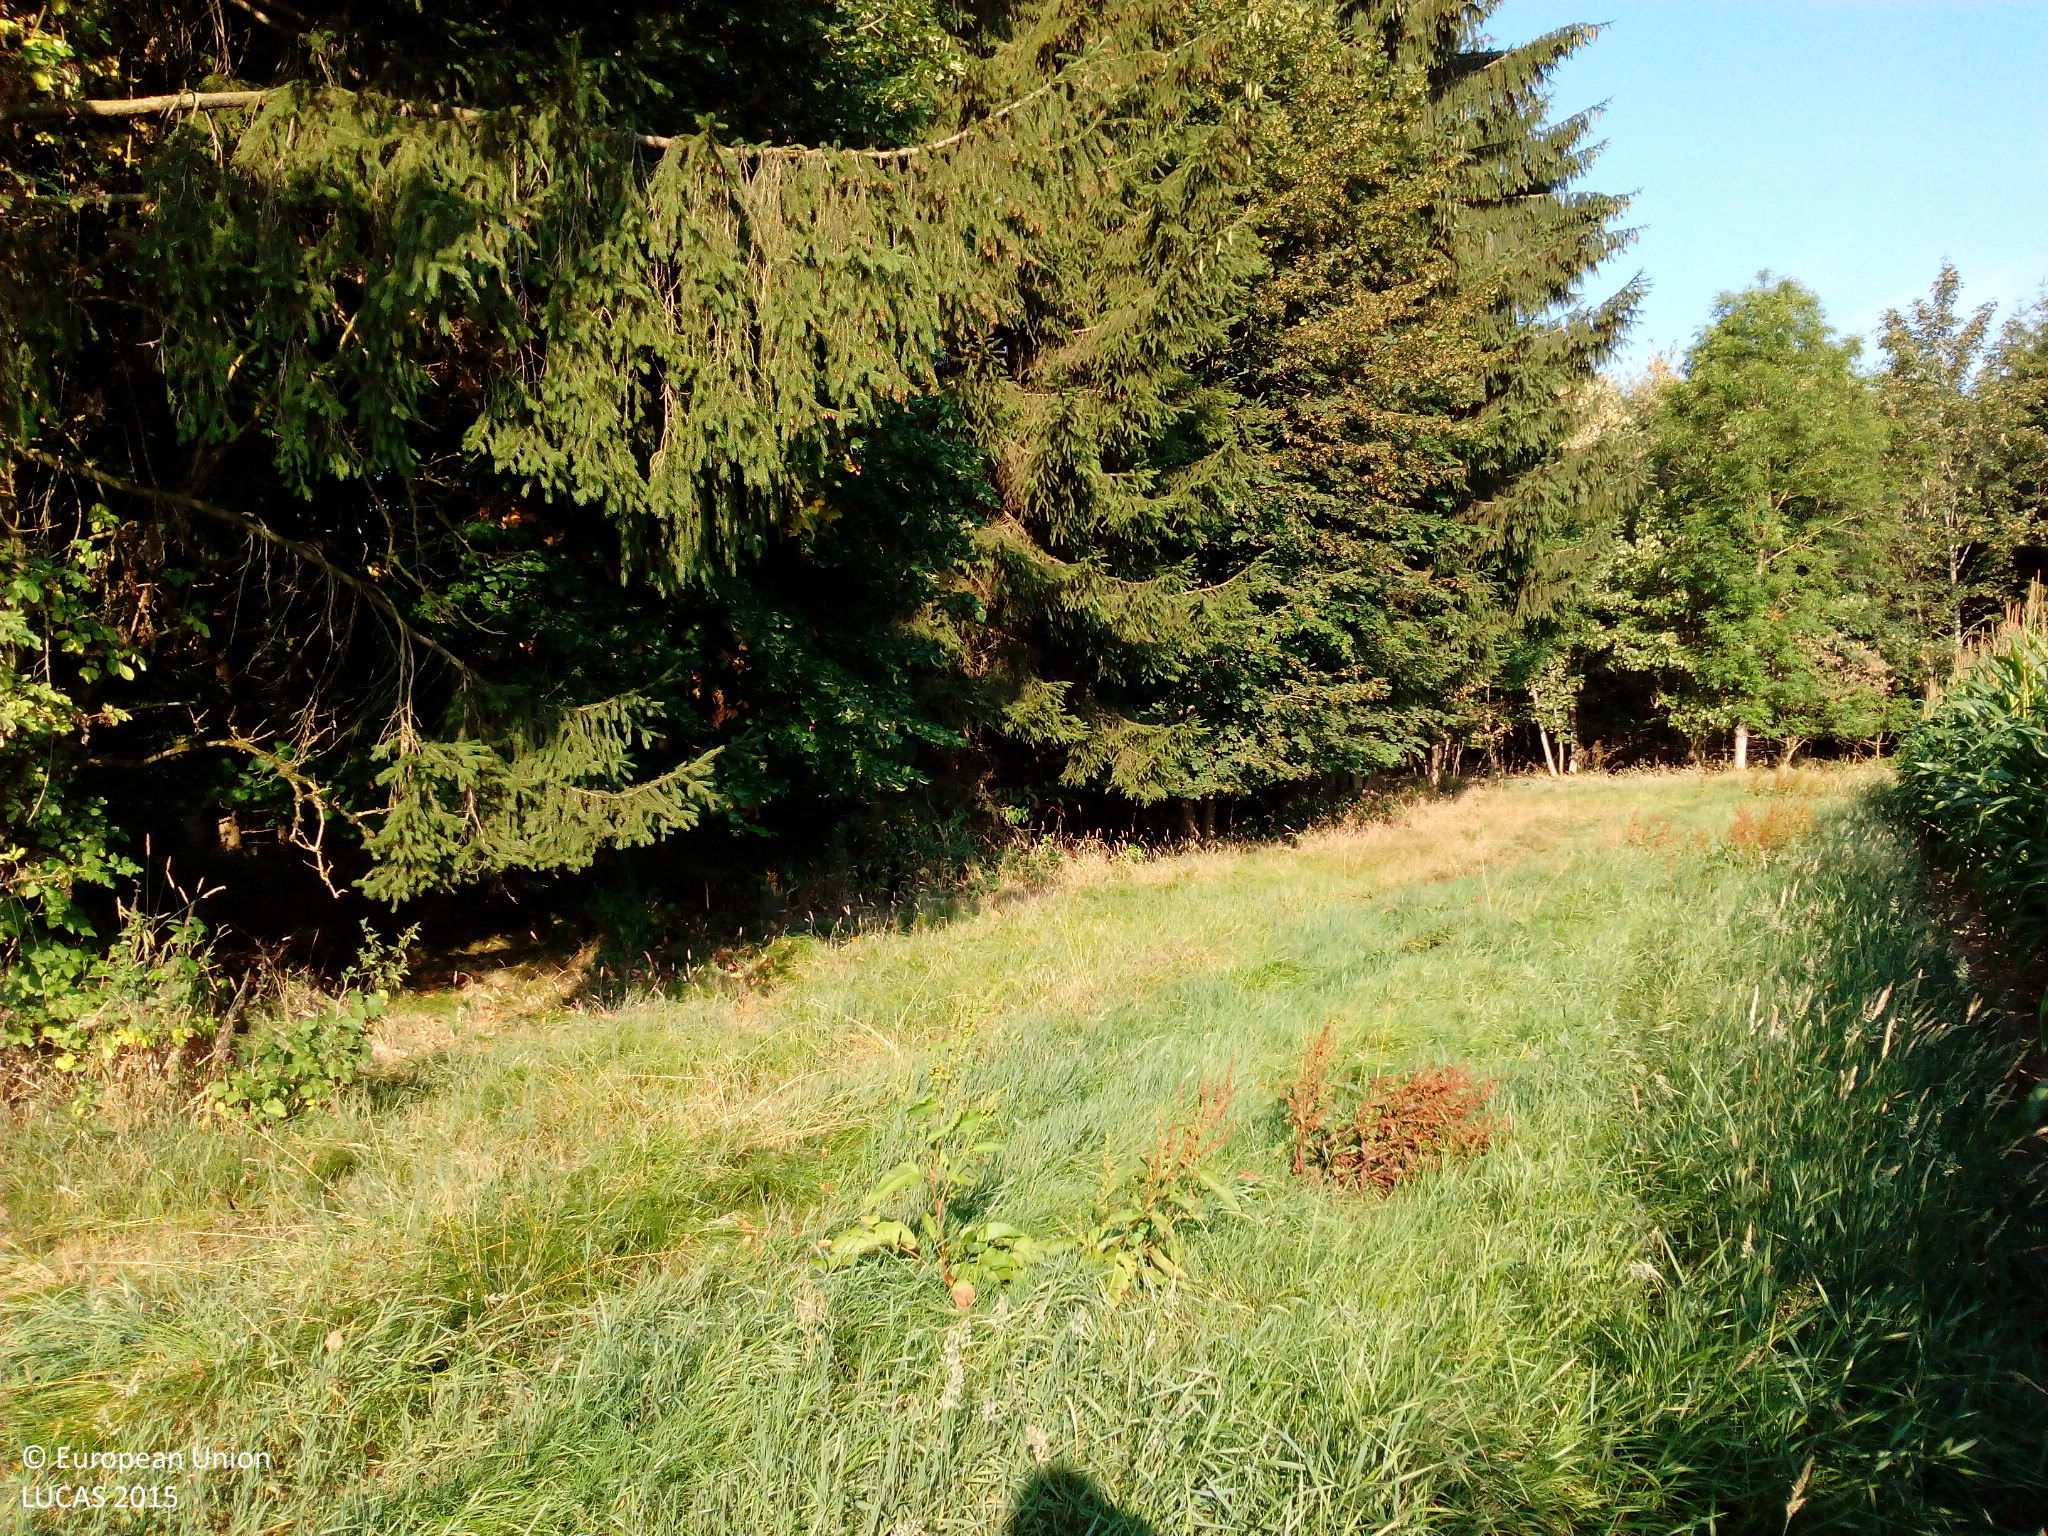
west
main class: Cropland
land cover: Maize
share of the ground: > 75 %
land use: Agriculture (excluding fallow land and kitchen gardens)
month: August
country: DE
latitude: 48.7441
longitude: 10.5301
